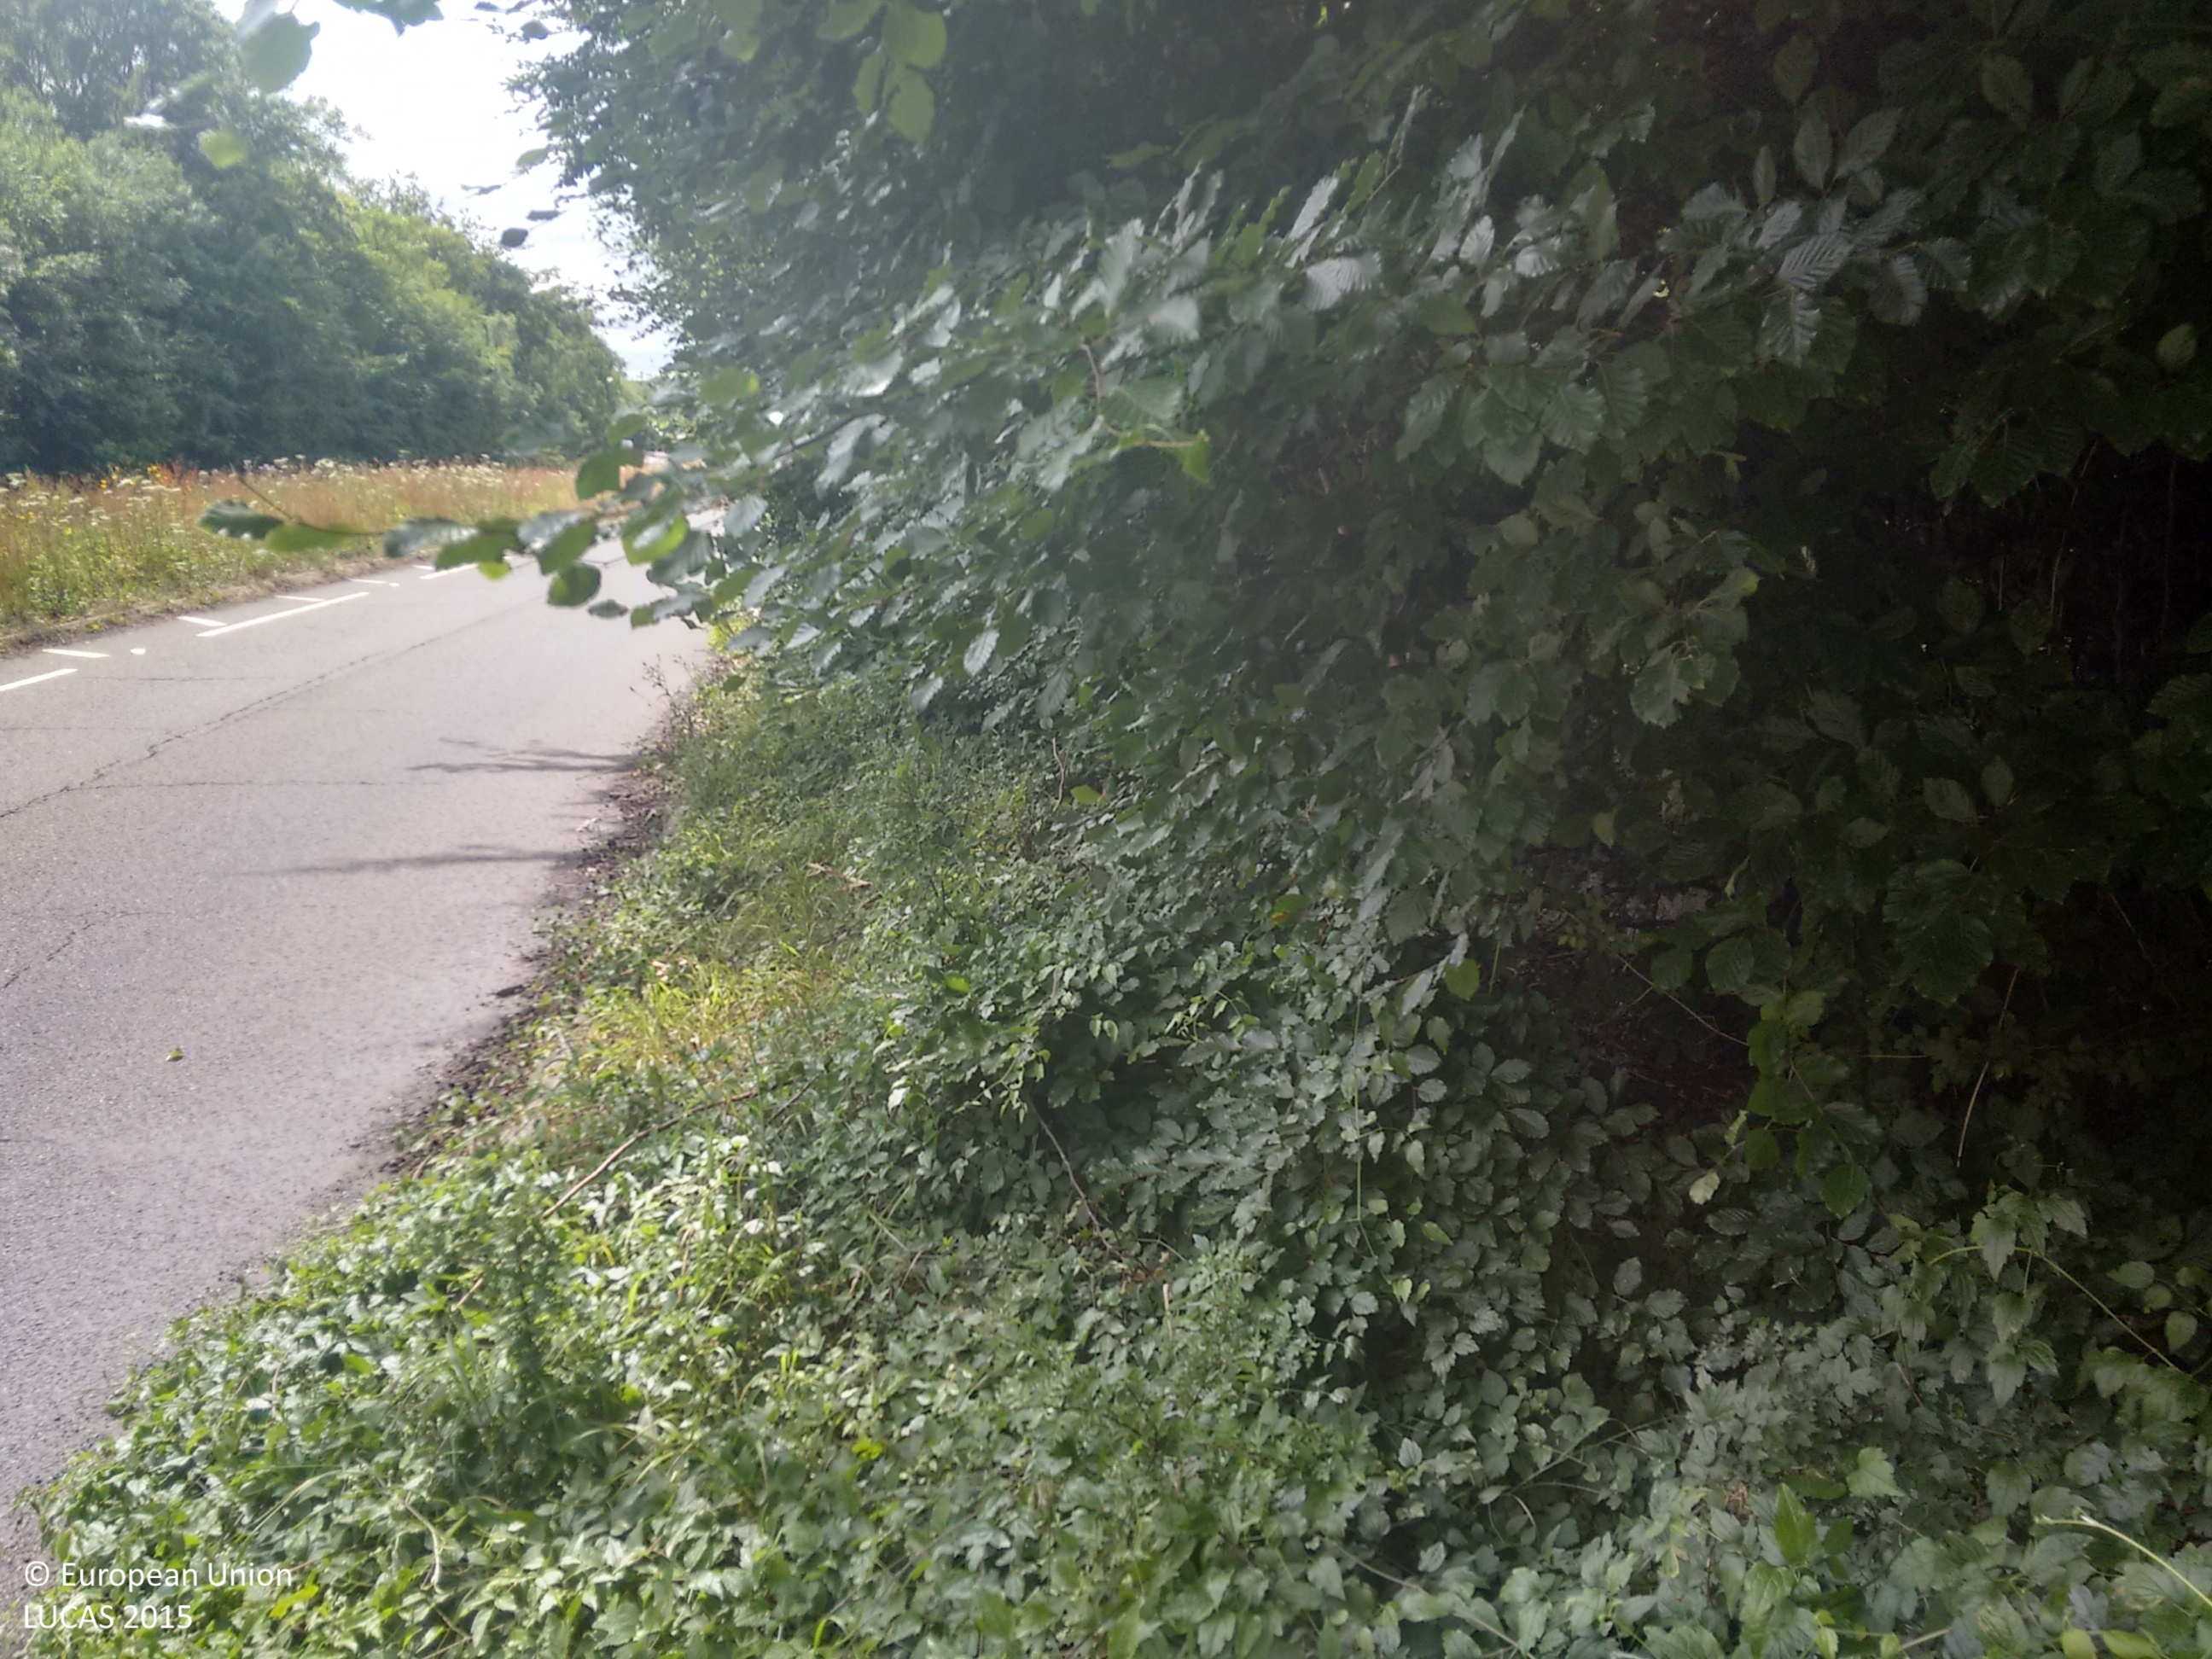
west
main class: Woodland
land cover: Other mixed woodland
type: hemiboreal forest and nemoral coniferous forest and mixed broadleaved-coniferous forest
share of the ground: > 75 %
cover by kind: coniferous forest trees 50 %, broadleaved forest trees 50 %
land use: Road transport
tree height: > 5 m
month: July
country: GB
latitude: 51.2283
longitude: -0.6225
